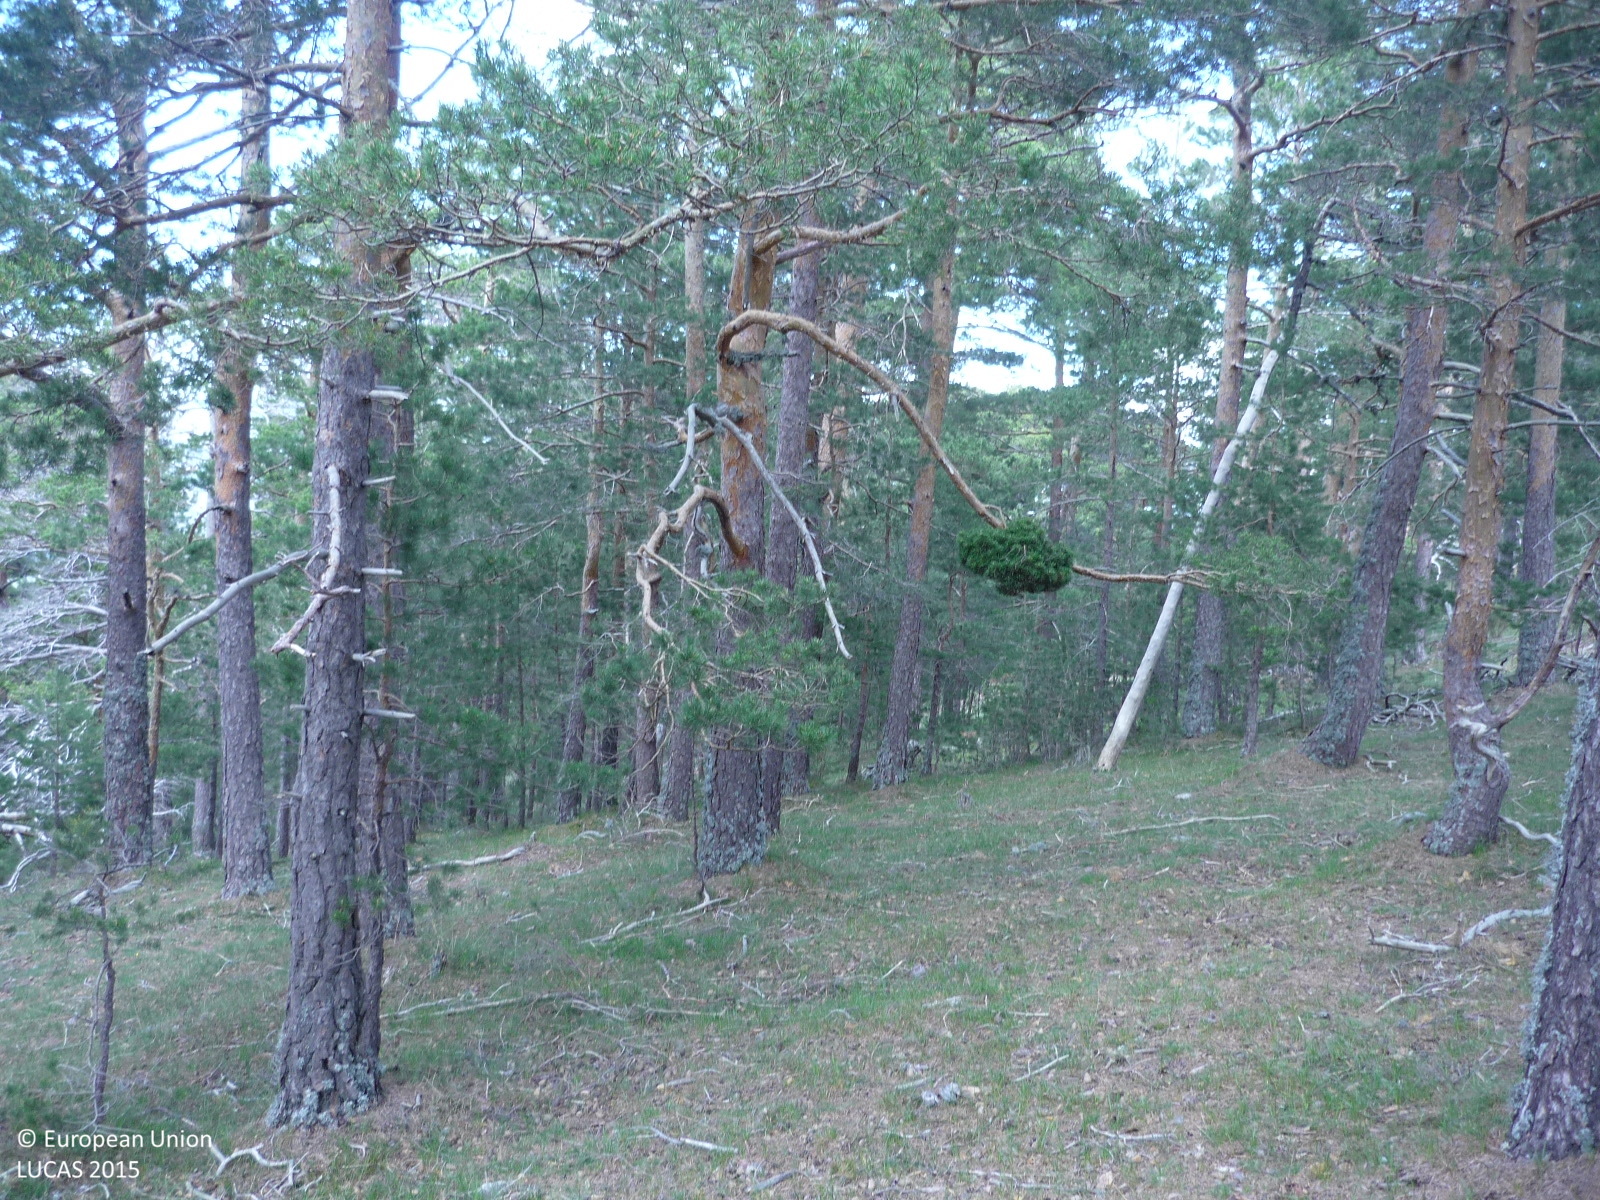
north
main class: Woodland
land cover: Pine dominated coniferous woodland
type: coniferous forest of the mediterranean region
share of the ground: > 75 %
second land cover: Grassland without tree/shrub cover
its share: > 75 %
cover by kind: coniferous forest trees 80 %, shrubs 10 %, herbaceous plants 10 %
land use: Forestry
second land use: Agriculture (excluding fallow land and kitchen gardens)
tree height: > 5 m
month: May
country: ES
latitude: 40.8466
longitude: -3.9115
